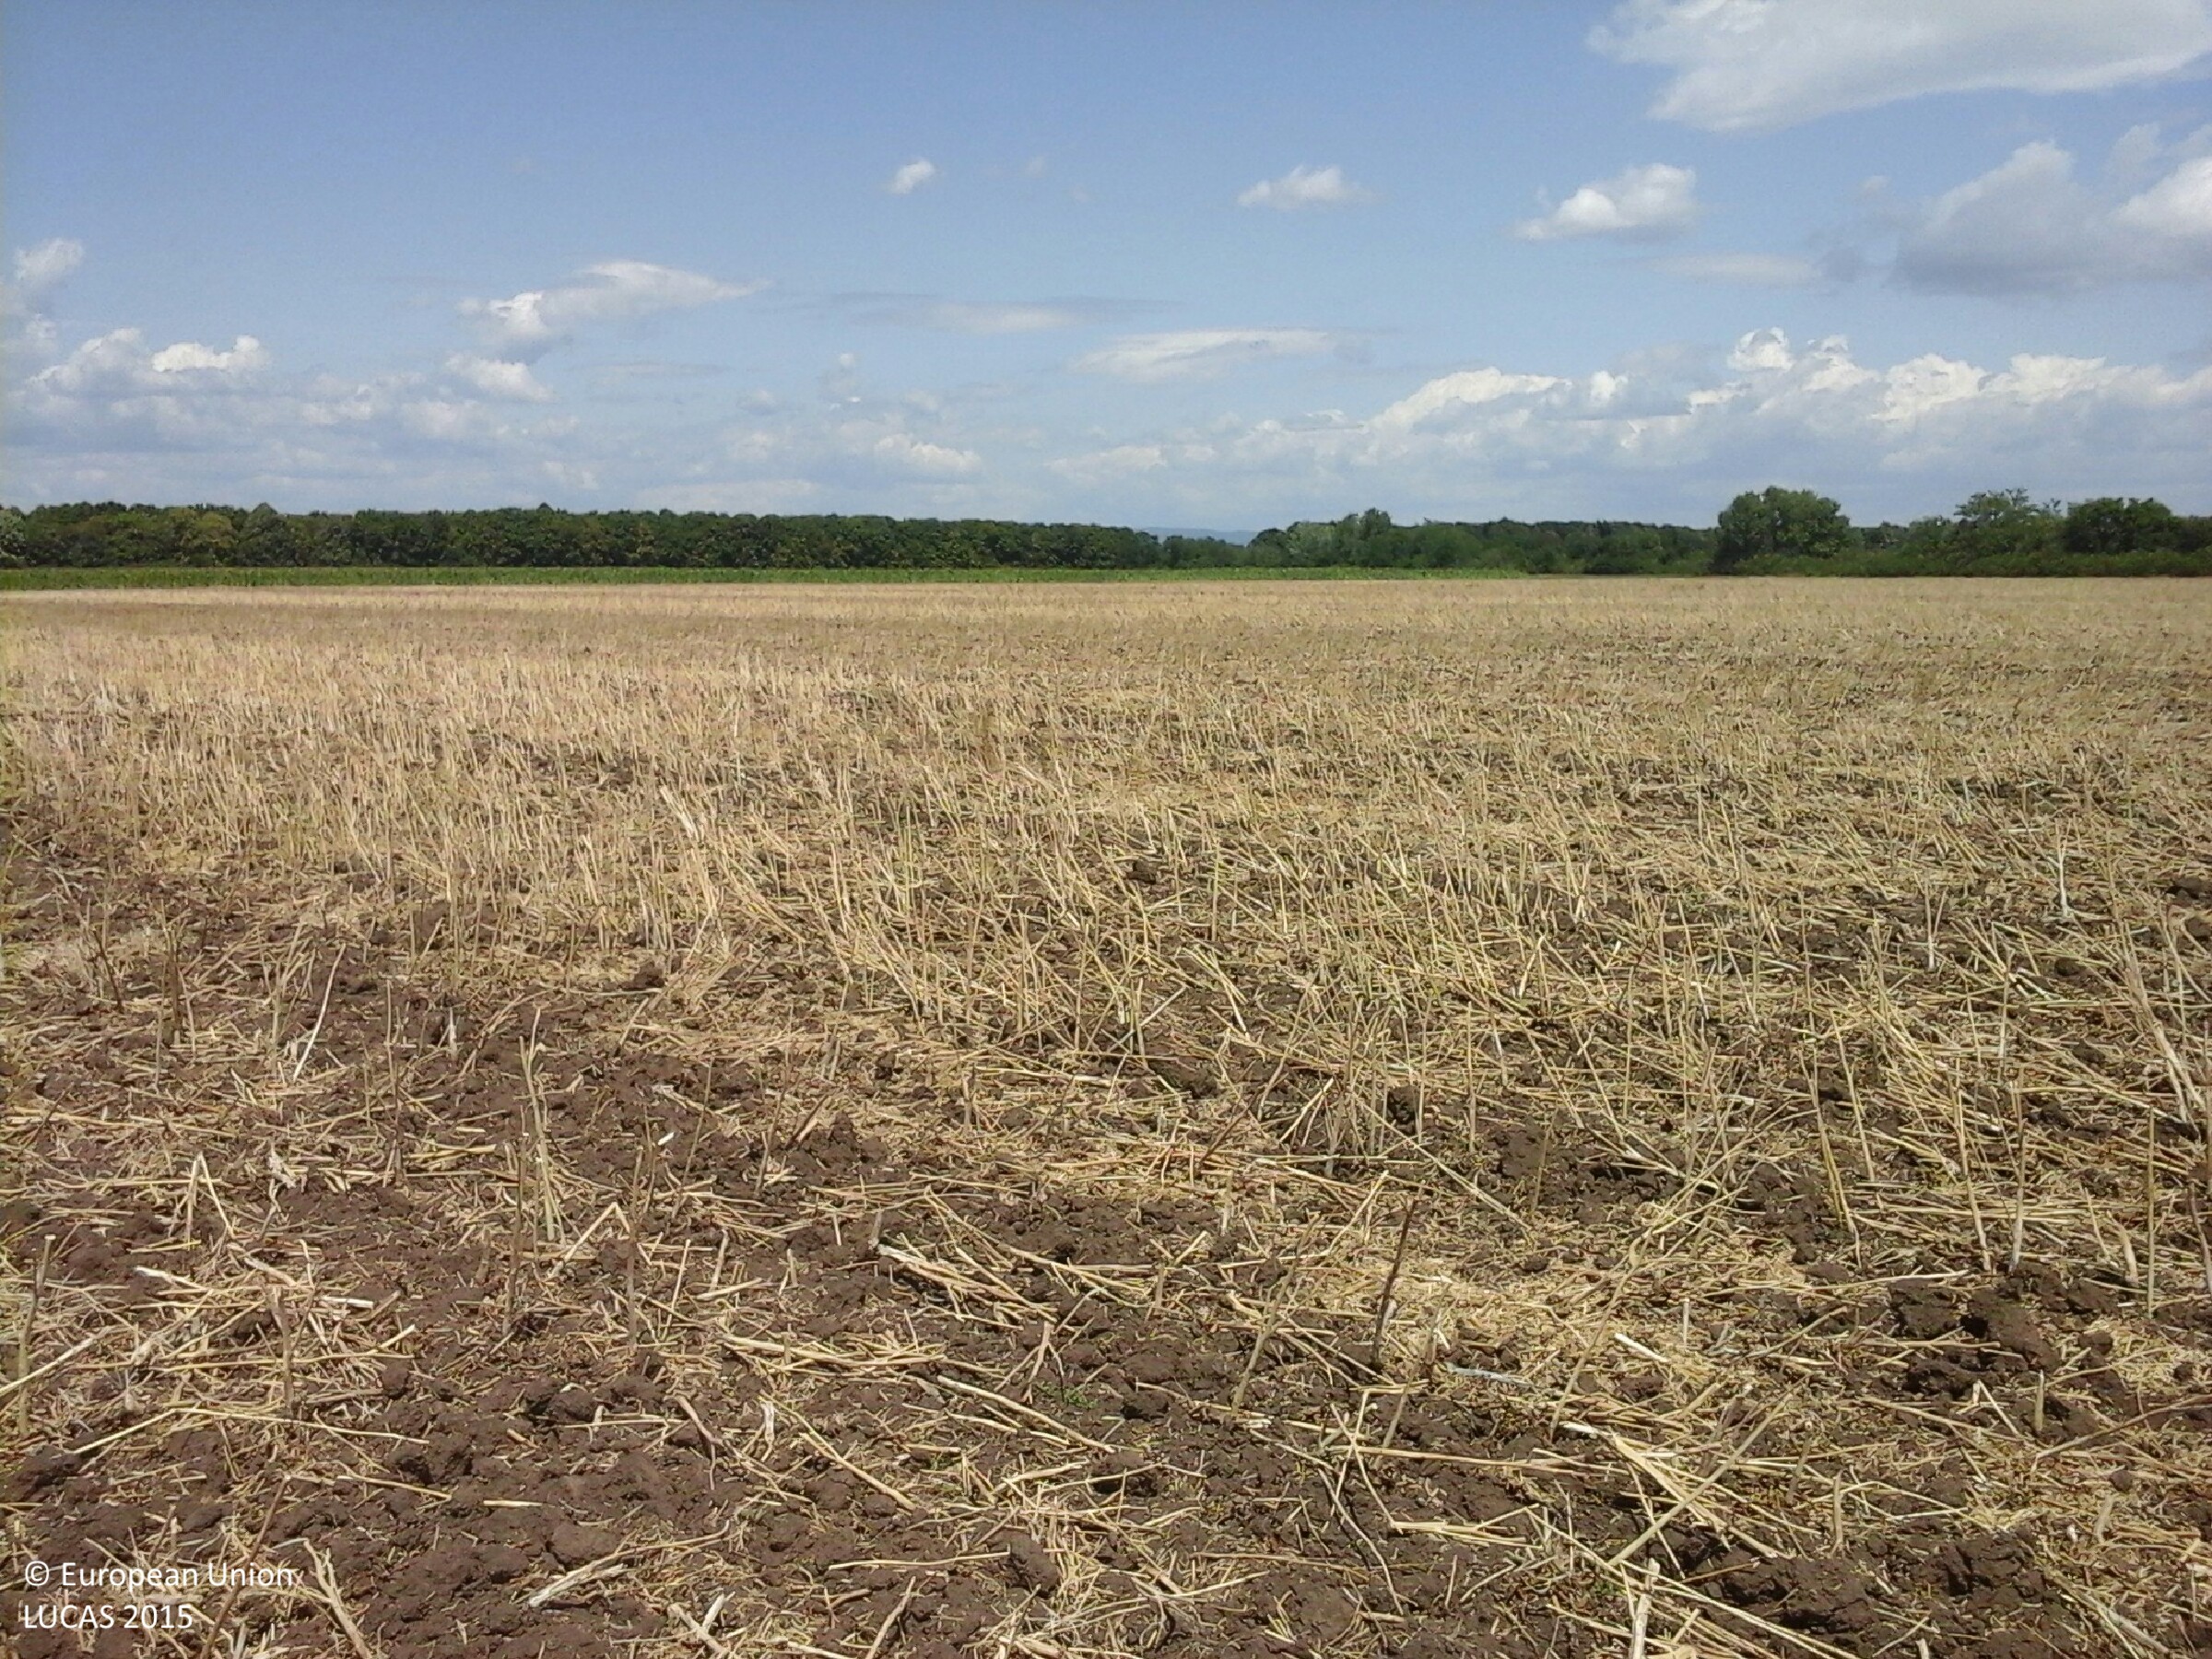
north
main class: Cropland
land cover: Rape and turnip rape
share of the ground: 25 - 50 %
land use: Agriculture (excluding fallow land and kitchen gardens)
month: July
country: HU
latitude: 47.8175
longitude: 20.6248
